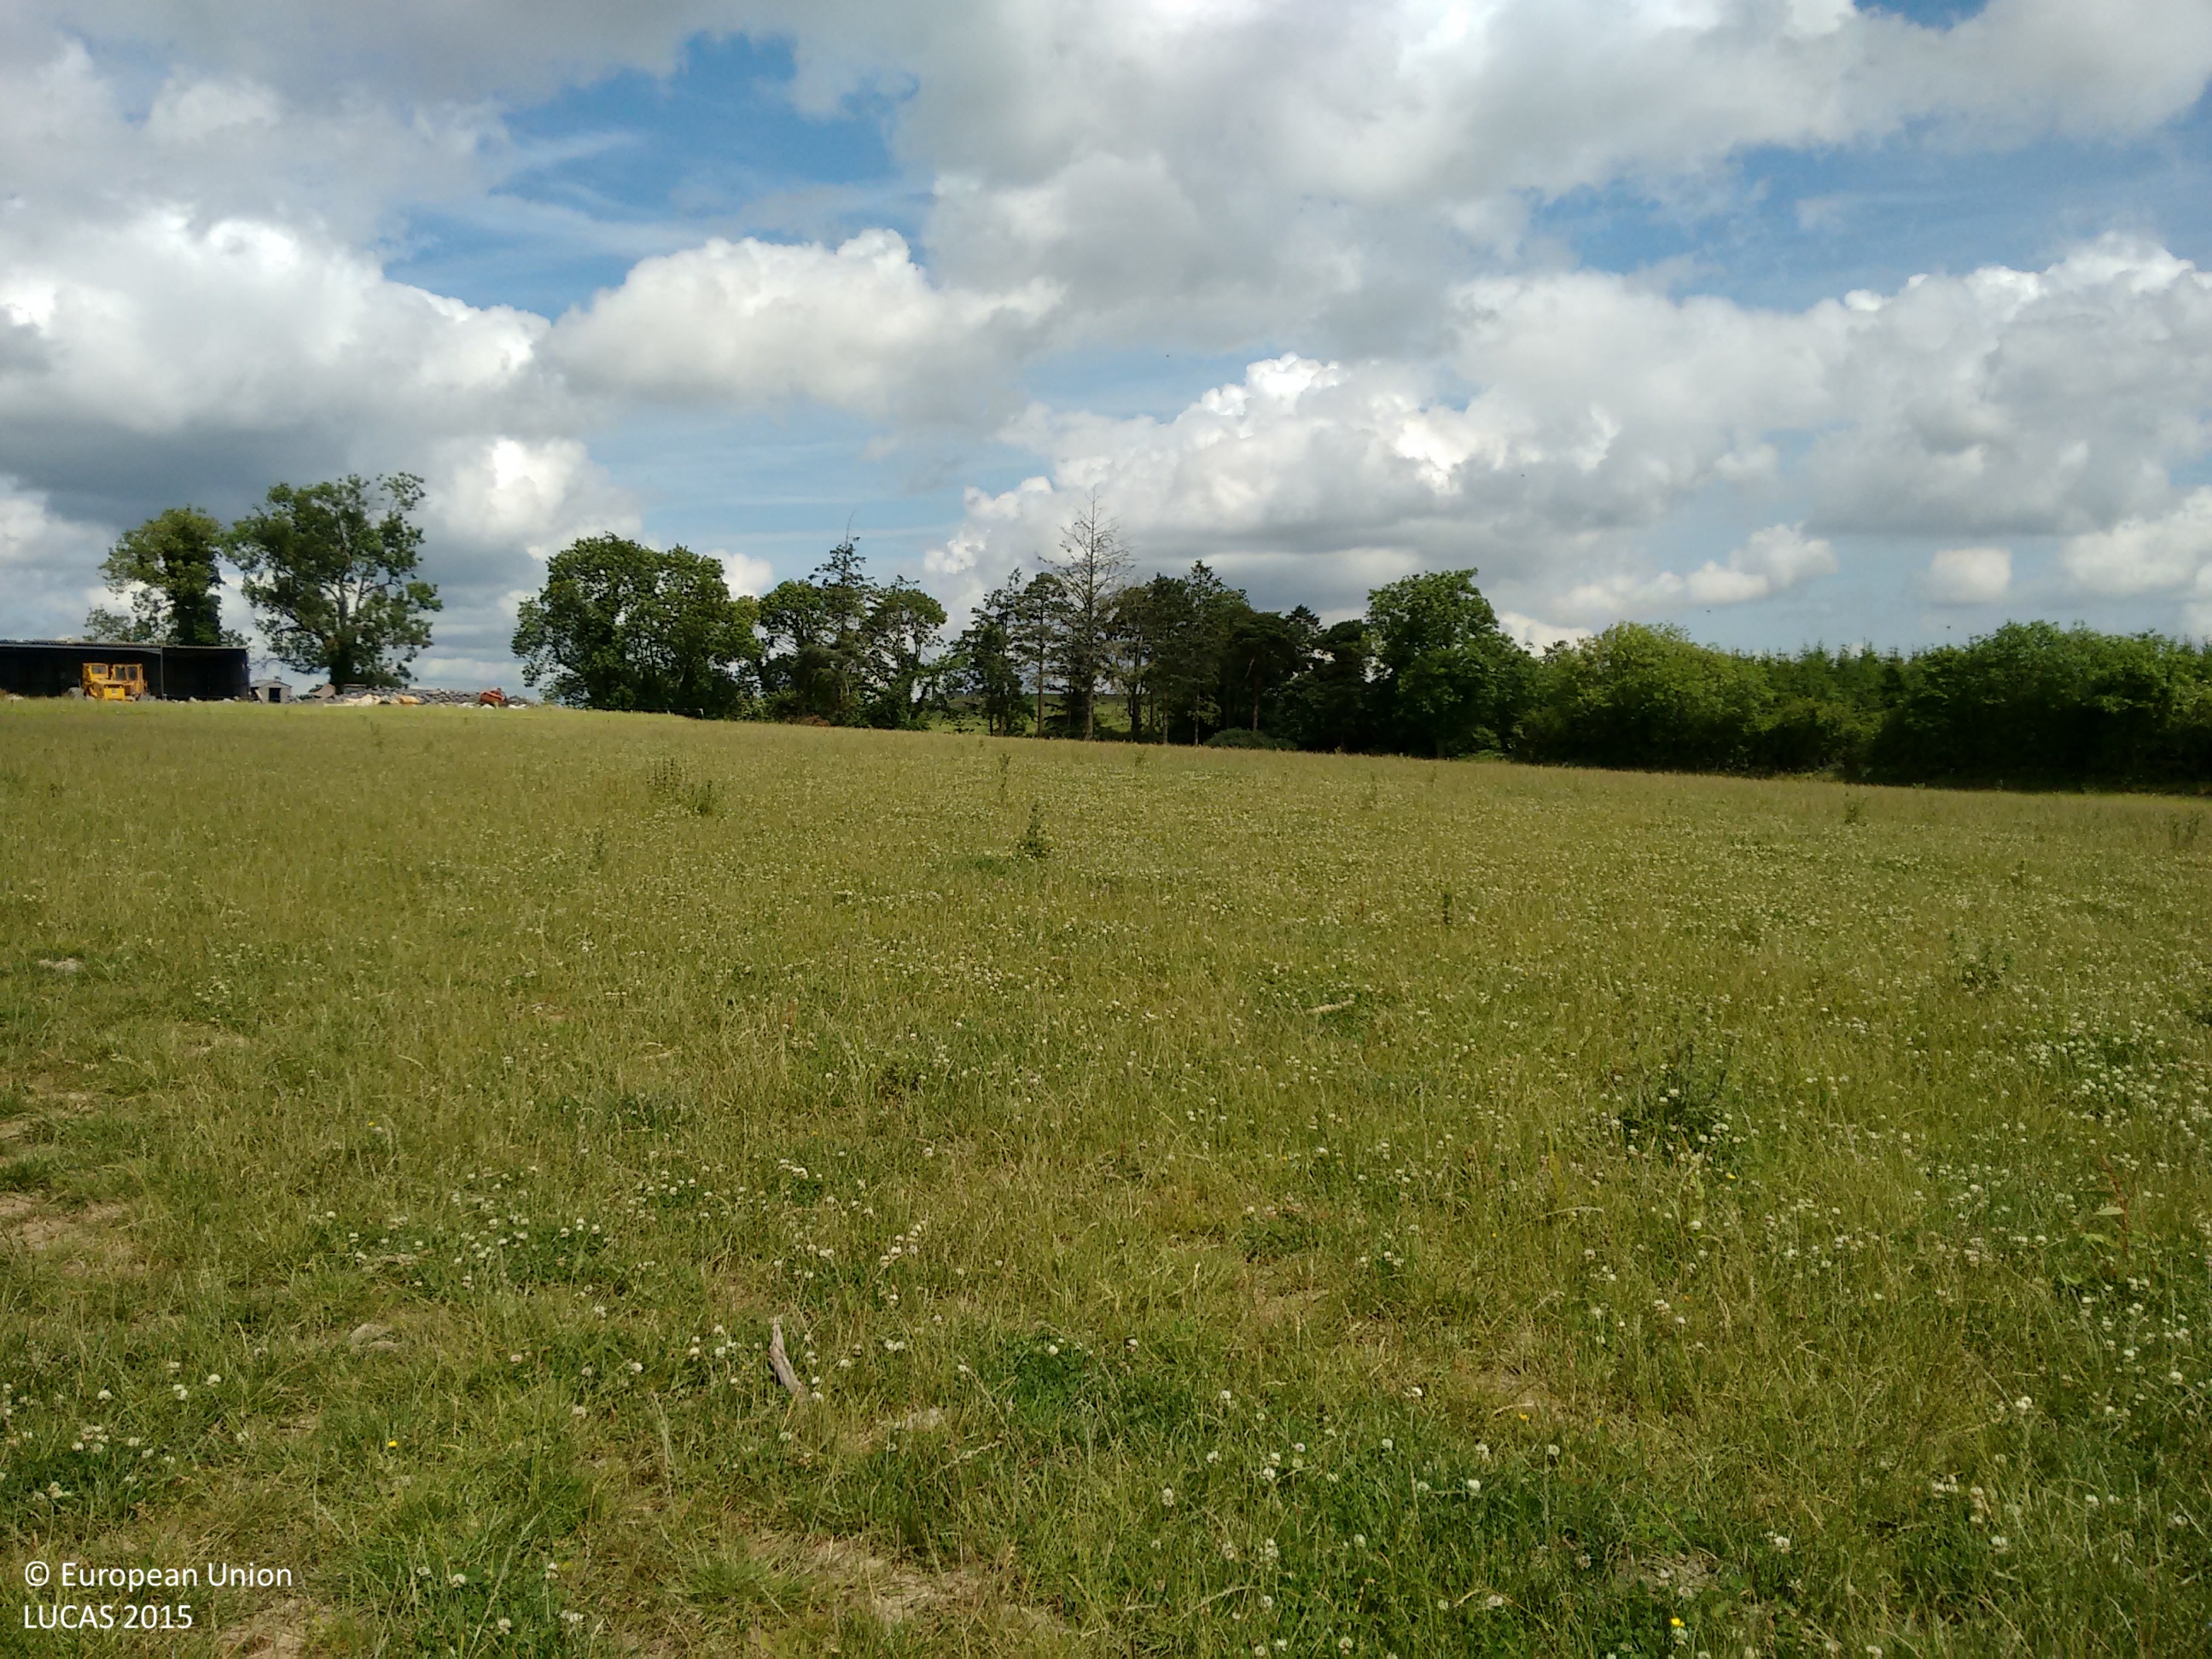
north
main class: Grassland
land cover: Grassland without tree/shrub cover
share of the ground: > 75 %
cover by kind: herbaceous plants 100 %
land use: Agriculture (excluding fallow land and kitchen gardens)
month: July
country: IE
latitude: 53.7991
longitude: -6.7901
